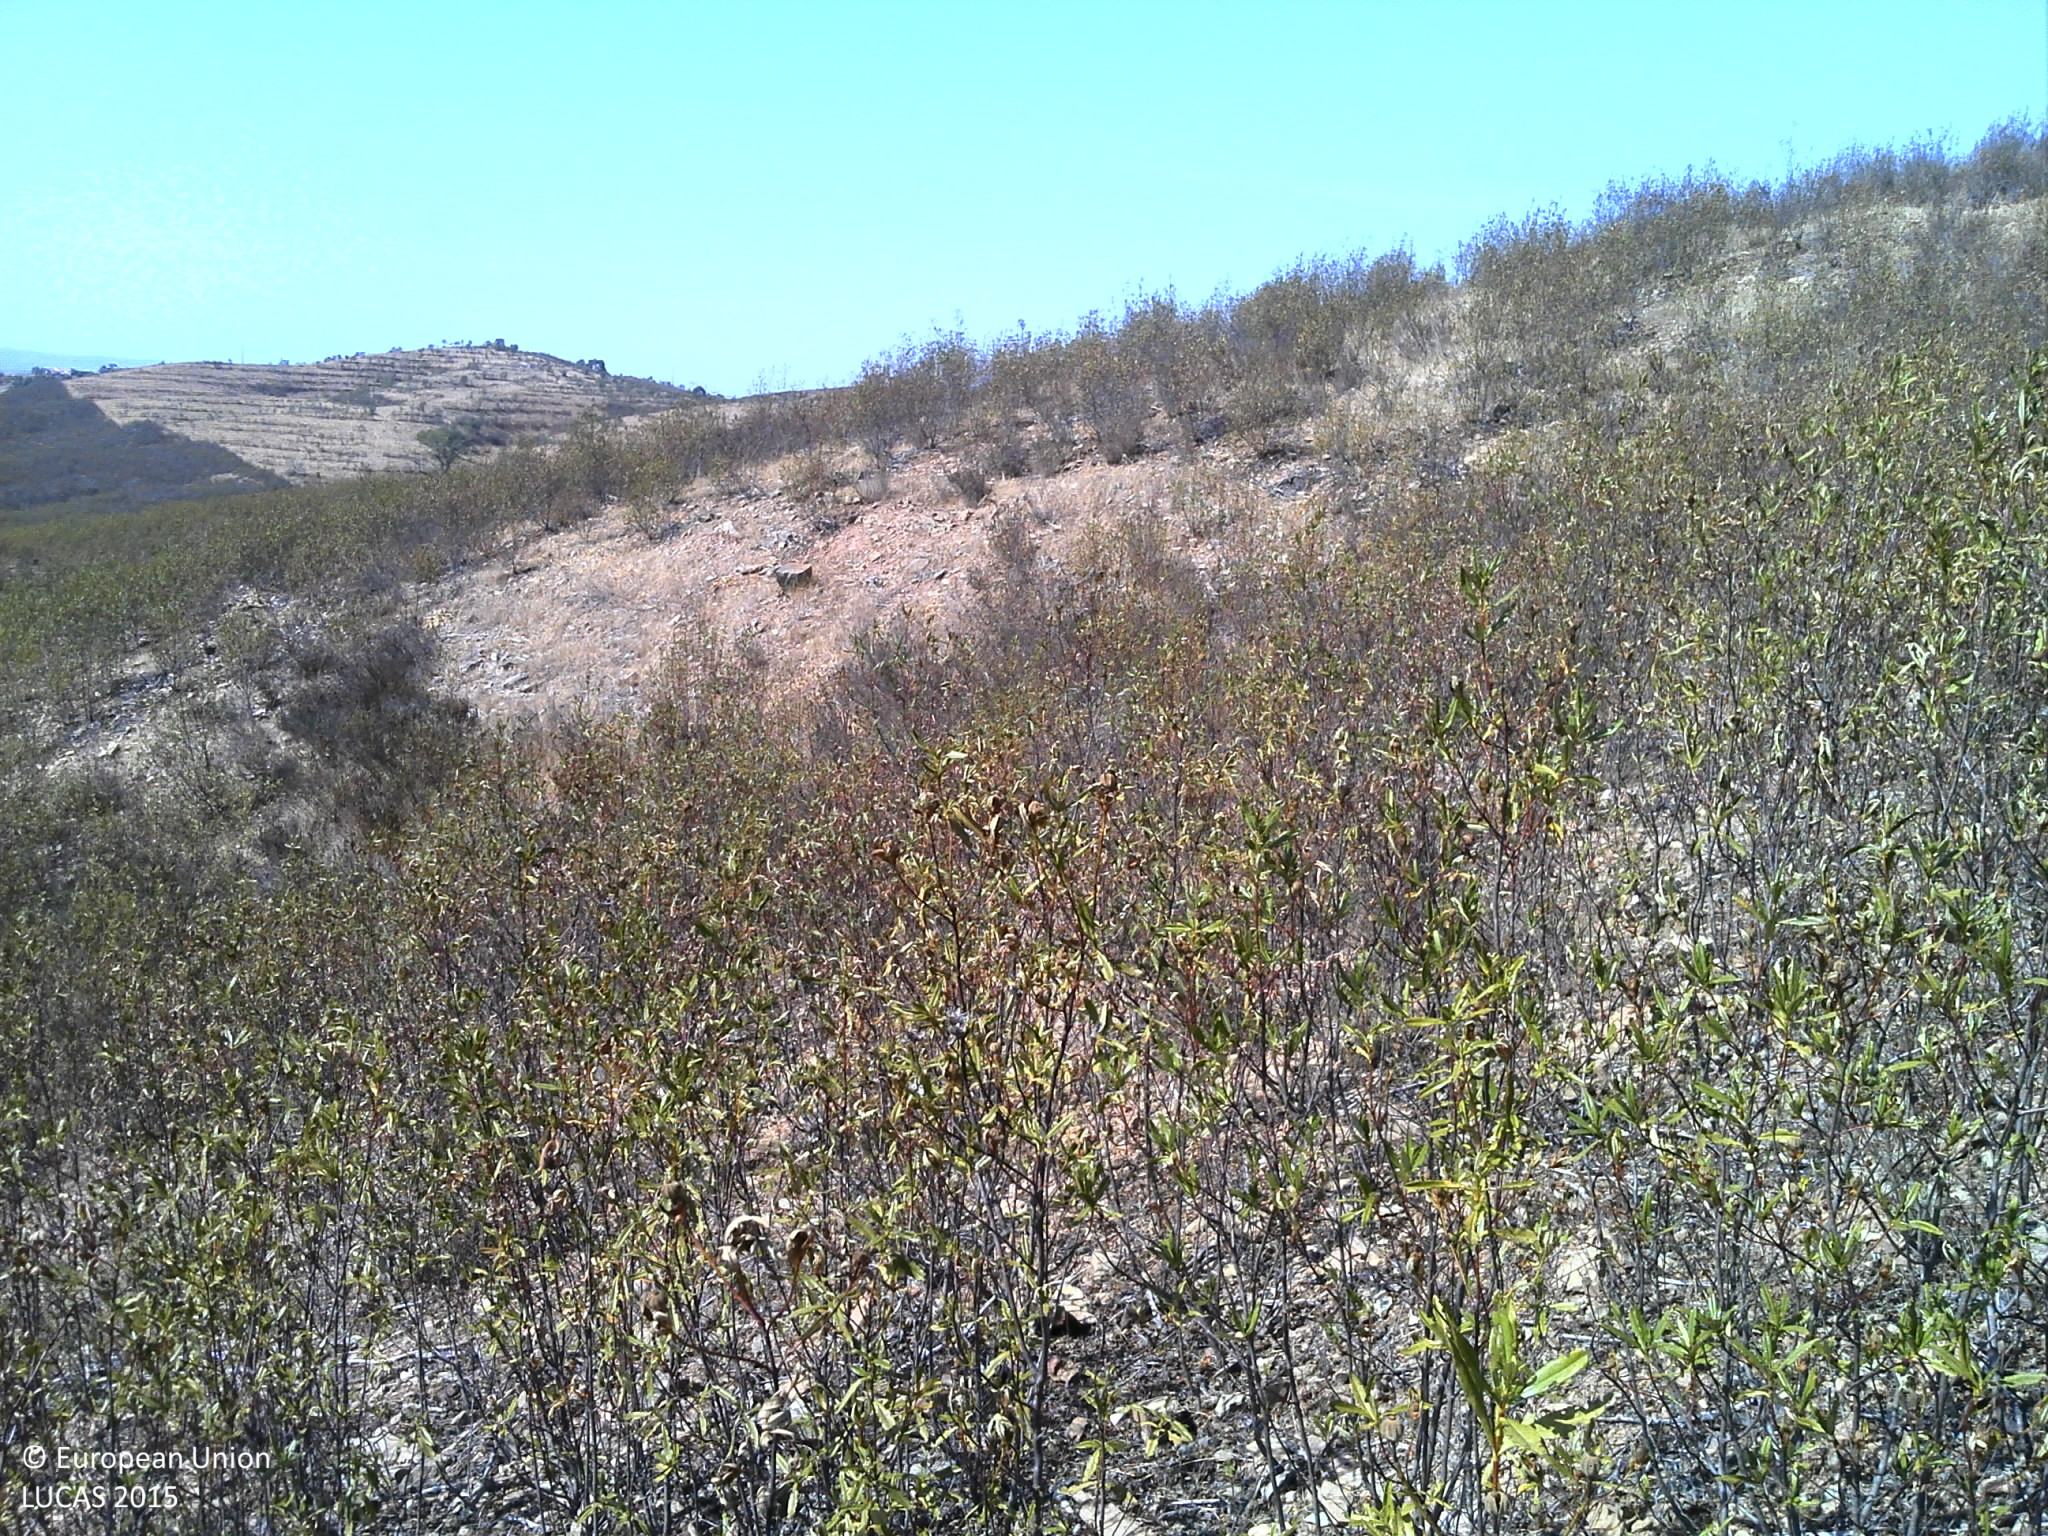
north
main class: Shrubland
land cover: Shrubland without tree cover
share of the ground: 25 - 50 %
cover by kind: unconsolidated bare surface 55 %, shrubs 45 %
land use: Abandoned areas
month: September
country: PT
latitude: 37.4586
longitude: -8.1916
